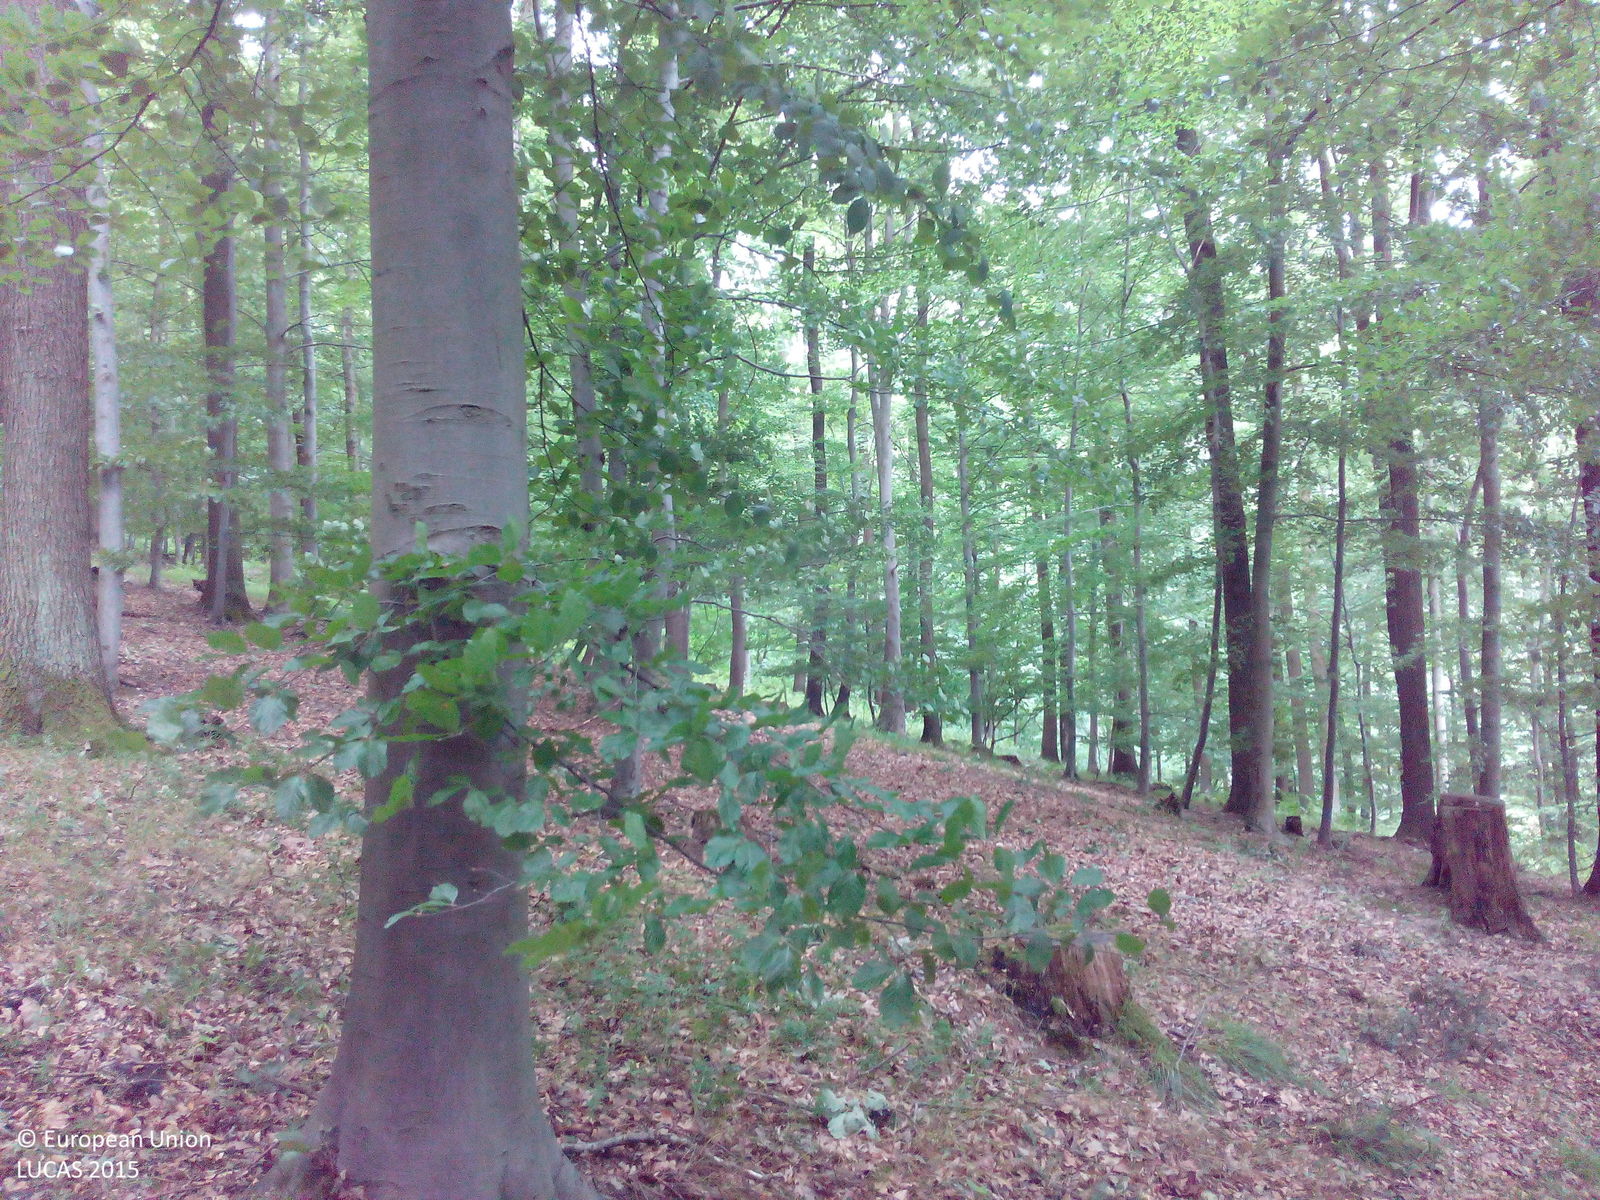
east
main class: Woodland
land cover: Broadleaved woodland
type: beech forest
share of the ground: > 75 %
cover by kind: broadleaved forest trees 100 %
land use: Forestry
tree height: > 5 m
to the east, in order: Broadleaved woodland
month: July
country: DE
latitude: 51.7843
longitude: 9.9565
